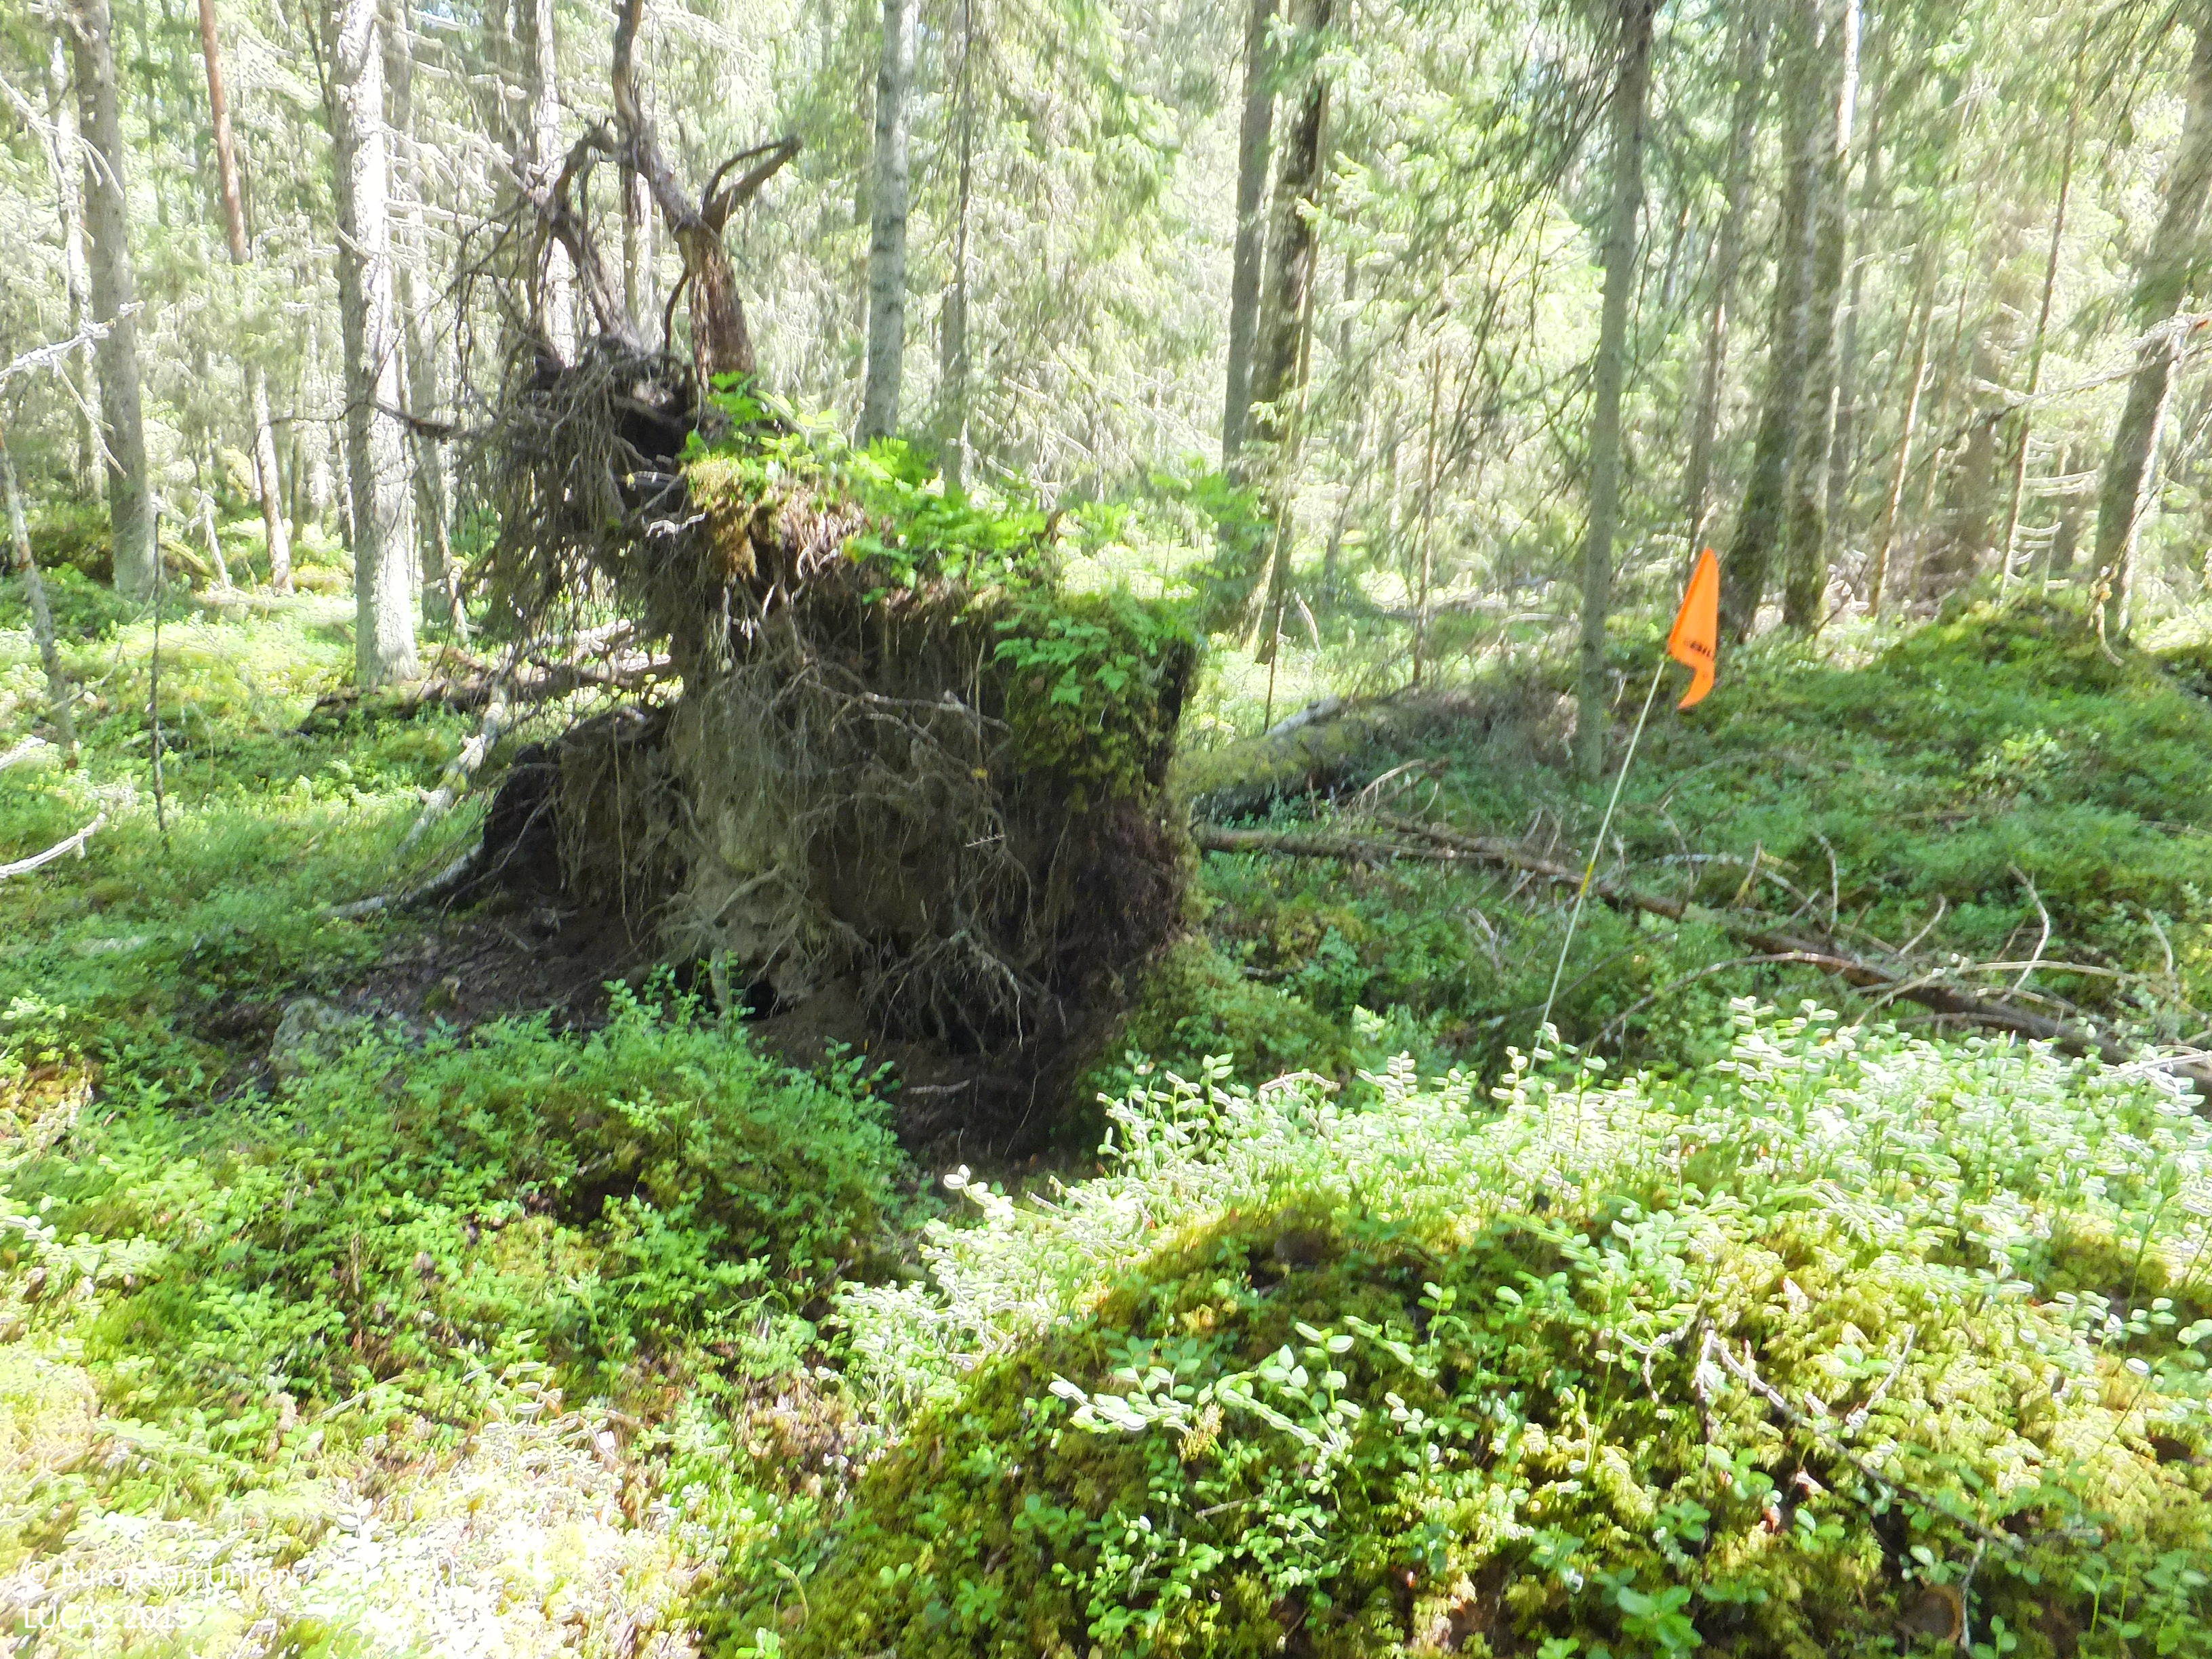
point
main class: Woodland
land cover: Spruce dominated mixed woodland
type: boreal forest
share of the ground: > 75 %
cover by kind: coniferous forest trees 50 %, broadleaved forest trees 30 %, shrubs 10 %, lichens and mosses 10 %
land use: Forestry
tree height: > 5 m
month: August
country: FI
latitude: 63.0994
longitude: 22.2310
